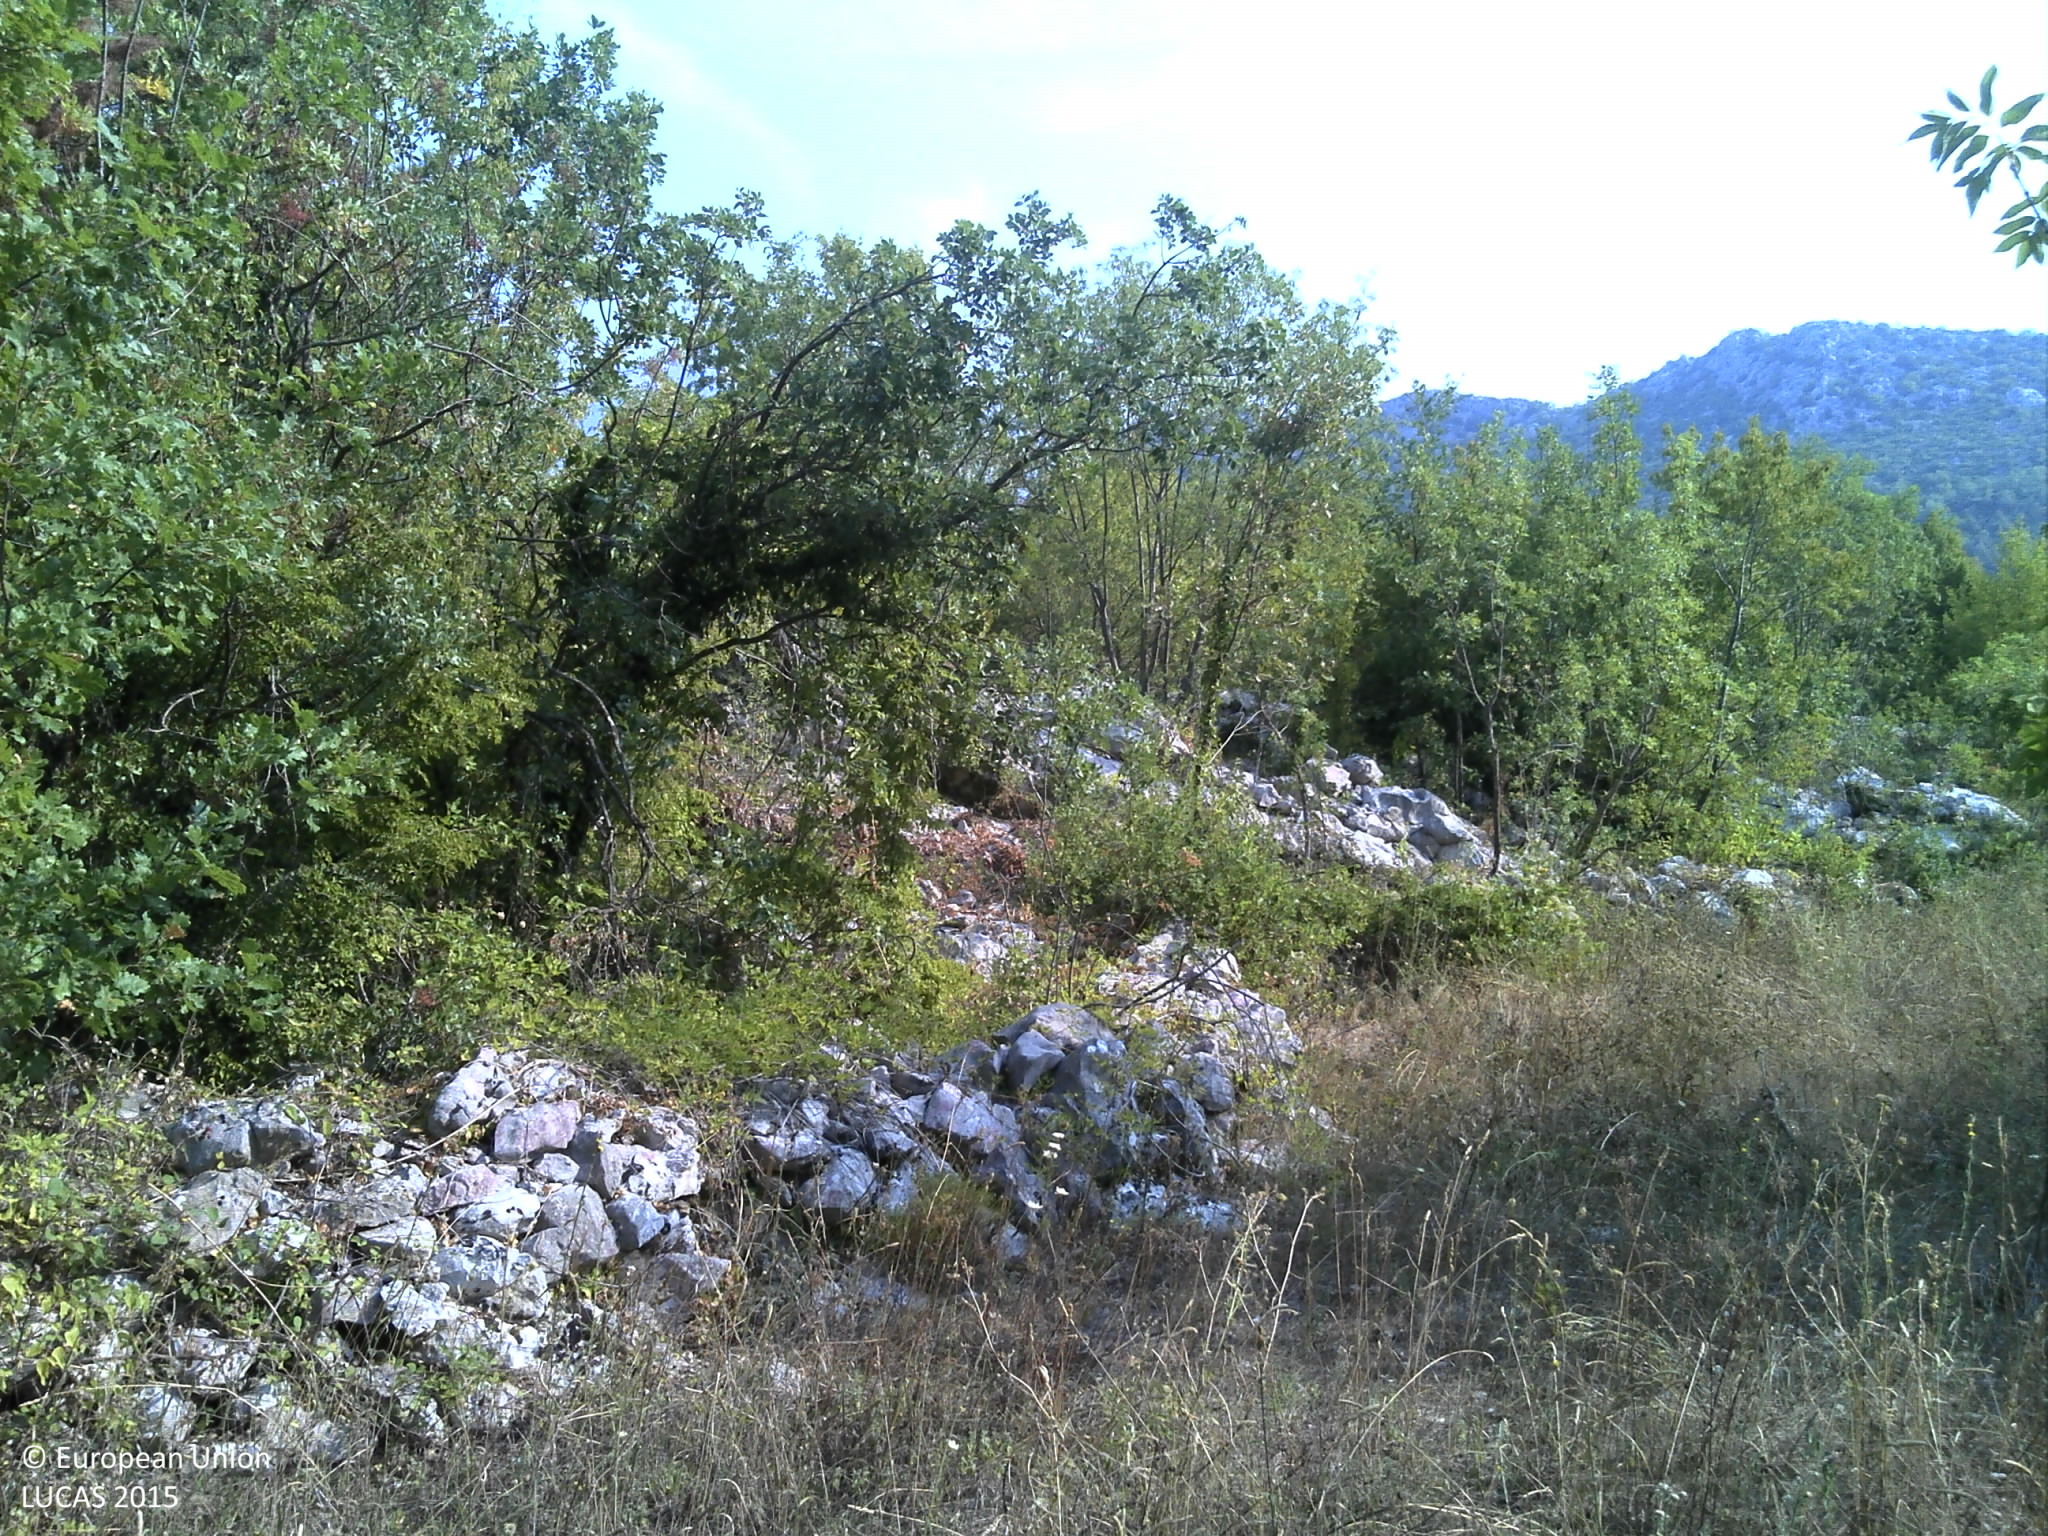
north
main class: Grassland
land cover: Grassland with sparse tree/shrub cover
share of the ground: > 75 %
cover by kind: herbaceous plants 80 %, shrubs 10 %, broadleaved forest trees 5 %, consolidated bare surface 5 %
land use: Abandoned areas
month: August
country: HR
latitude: 43.2281
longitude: 17.2430
